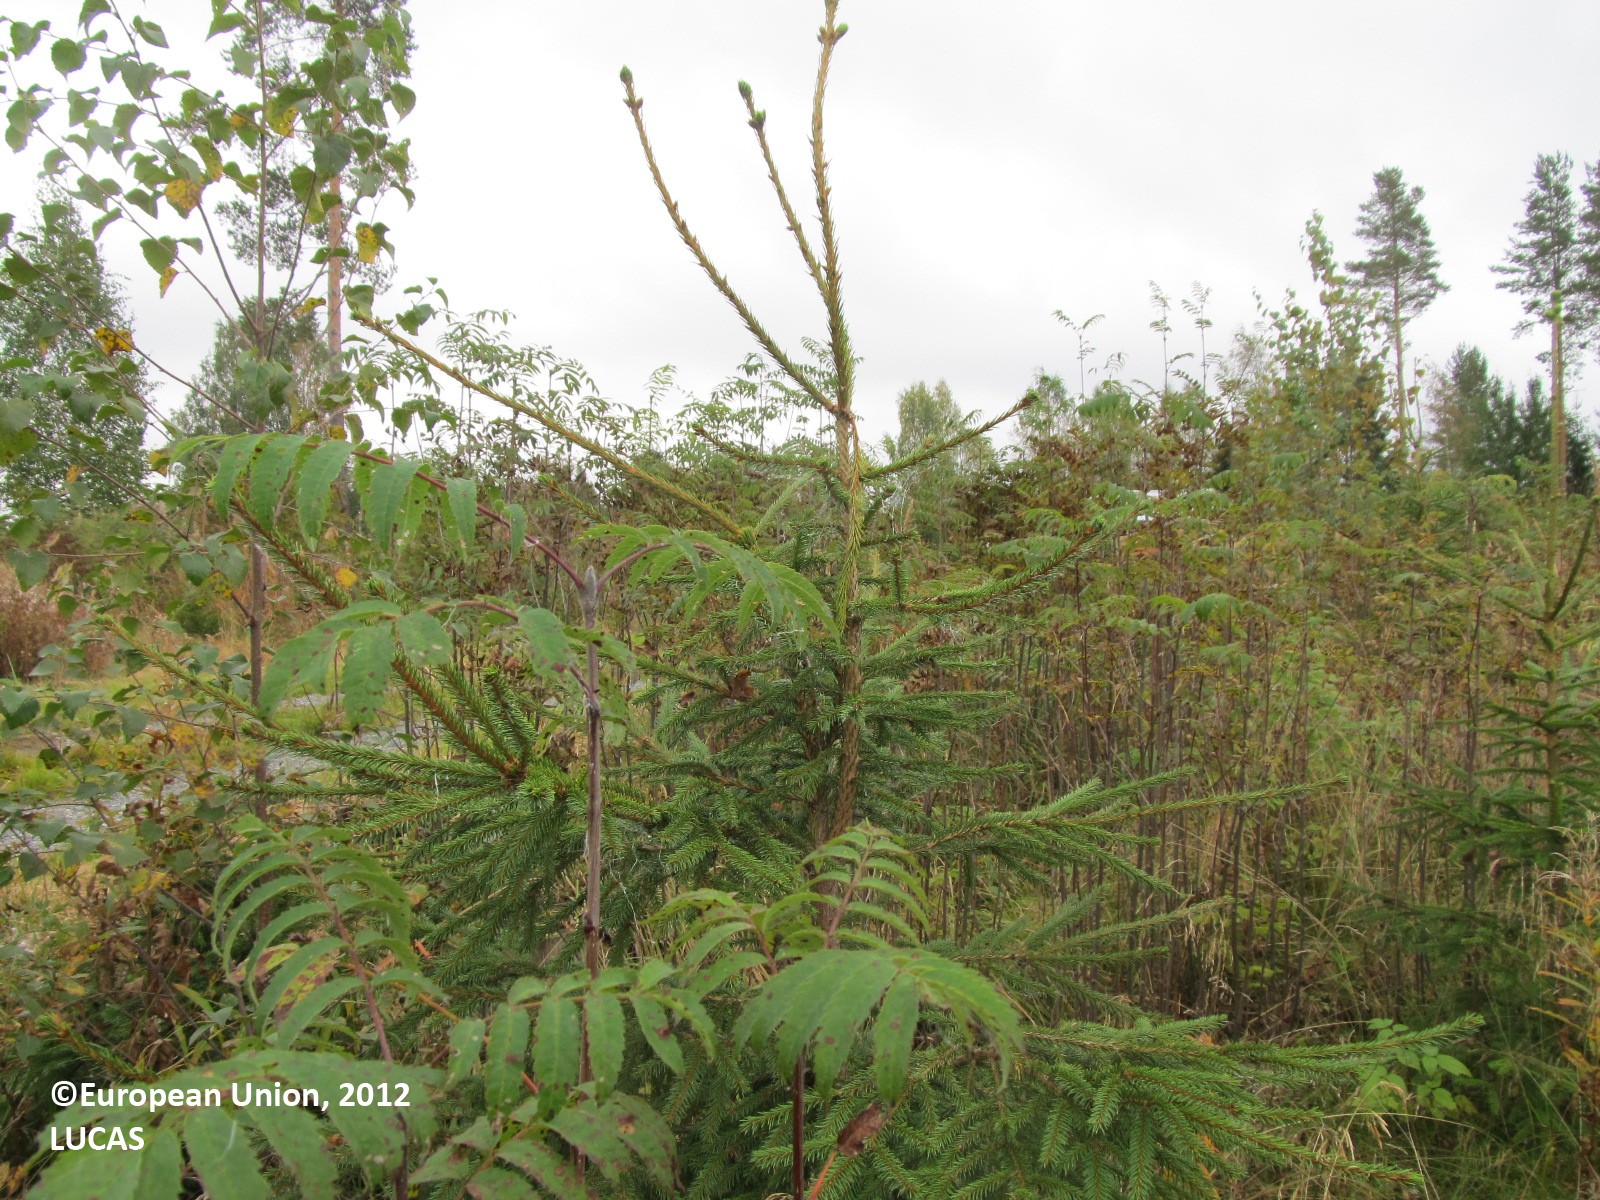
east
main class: Woodland
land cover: Spruce dominated mixed woodland
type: boreal forest
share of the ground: > 75 %
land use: Forestry
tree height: < 5 m
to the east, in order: Spruce dominated mixed woodland; Tracks; Spruce dominated mixed woodland; Ditches and canals; Temporary grasslands; Ditches and canals; Temporary grasslands; Ditches and canals; Temporary grasslands; Ditches and canals; Temporary grasslands; Ditches and canals; Paved roads, cycling and walking lanes; Ditches and canals; Pine dominated mixed woodland
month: September
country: FI
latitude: 63.1222
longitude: 27.9186
